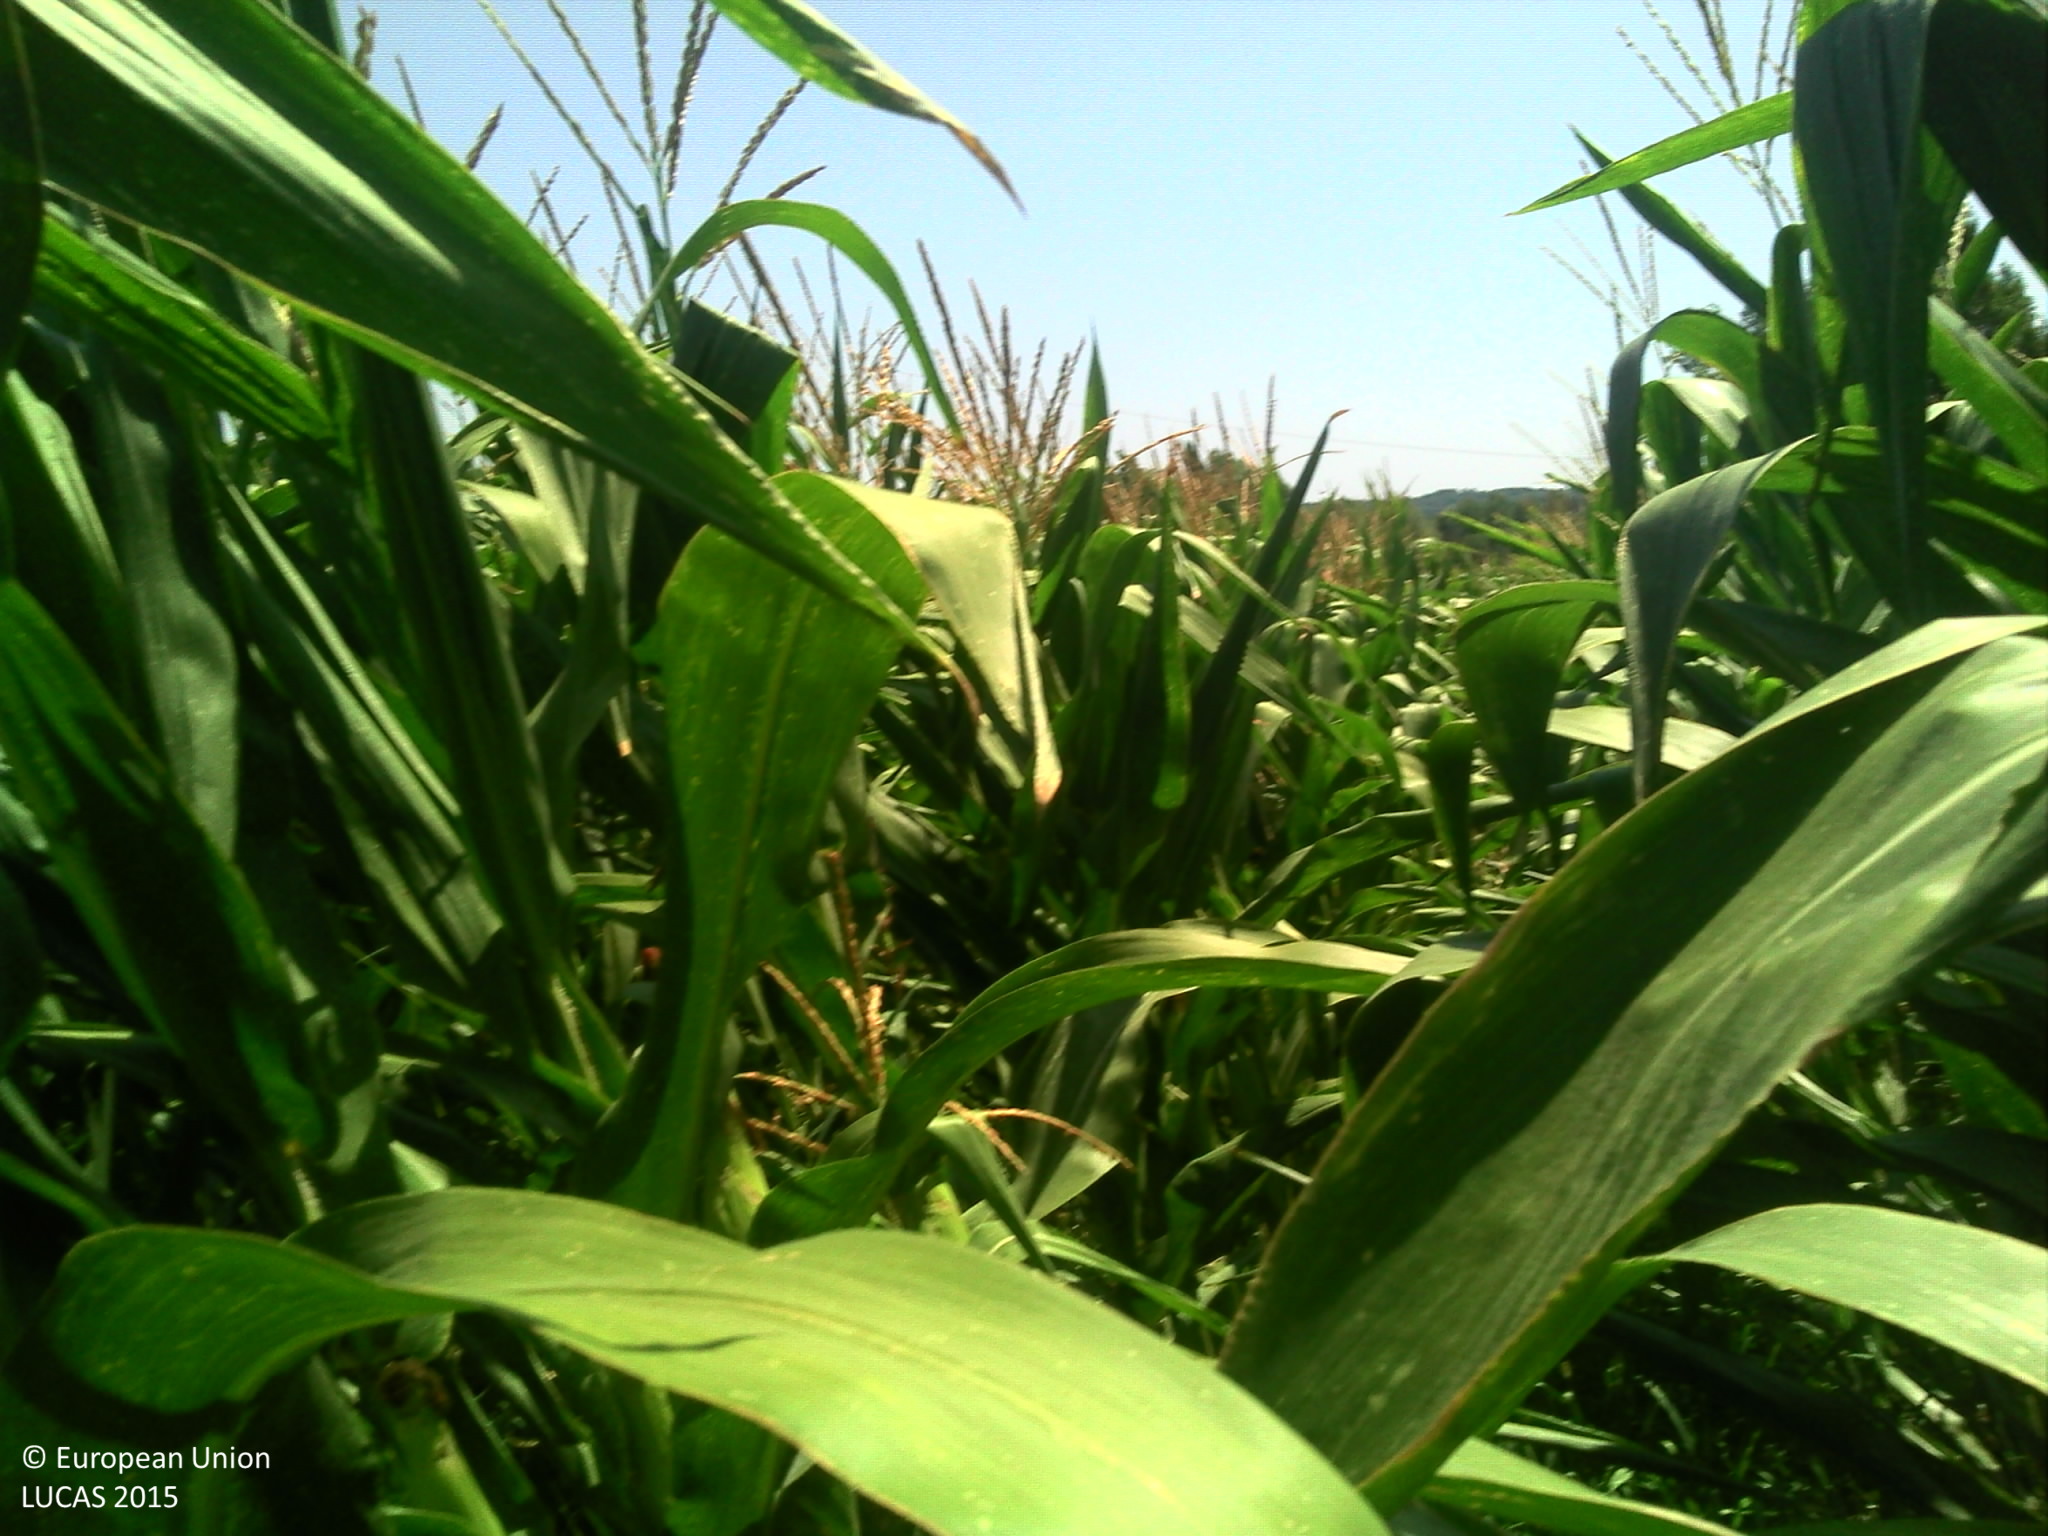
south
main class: Cropland
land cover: Maize
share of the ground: > 75 %
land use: Agriculture (excluding fallow land and kitchen gardens)
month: August
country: FR
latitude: 44.1865
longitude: 1.3294
